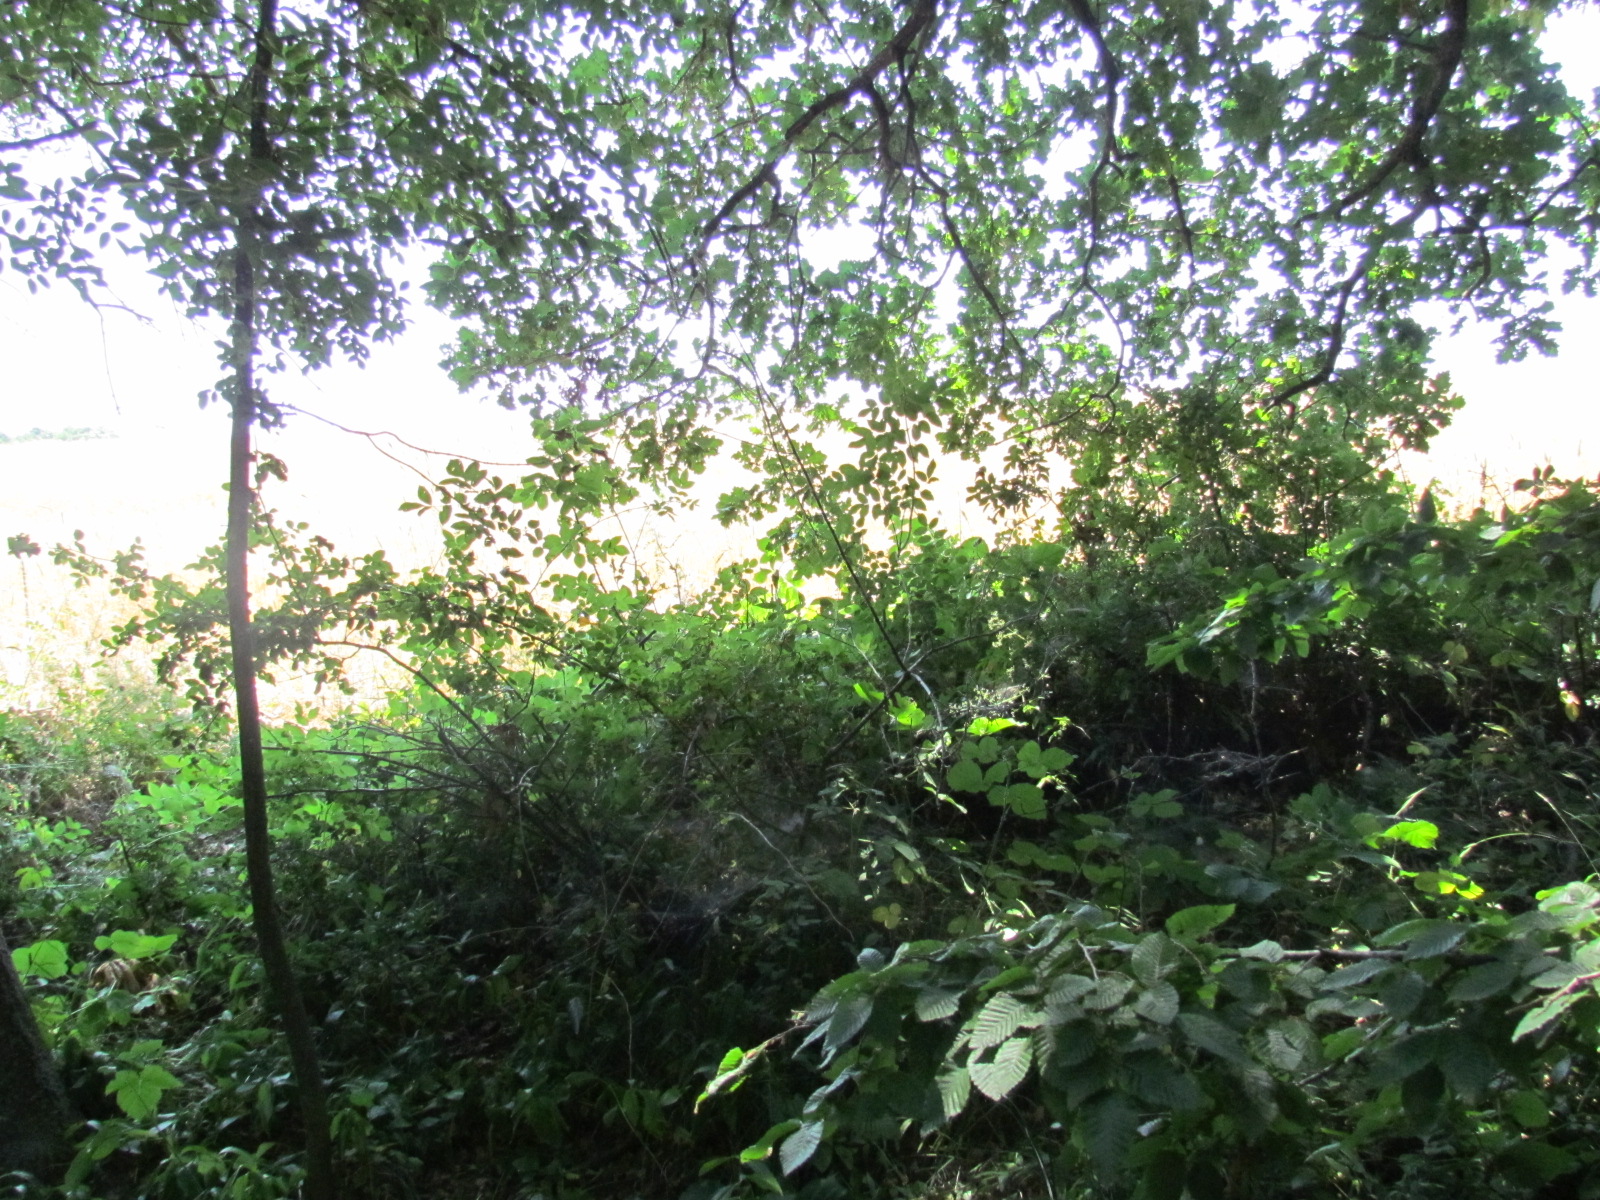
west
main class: Woodland
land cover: Broadleaved woodland
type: acidophilous oak and oak-birch forest
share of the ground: > 75 %
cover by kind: broadleaved forest trees 95 %, shrubs 5 %
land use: Forestry
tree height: > 5 m
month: July
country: BG
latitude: 42.7797
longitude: 27.8929
